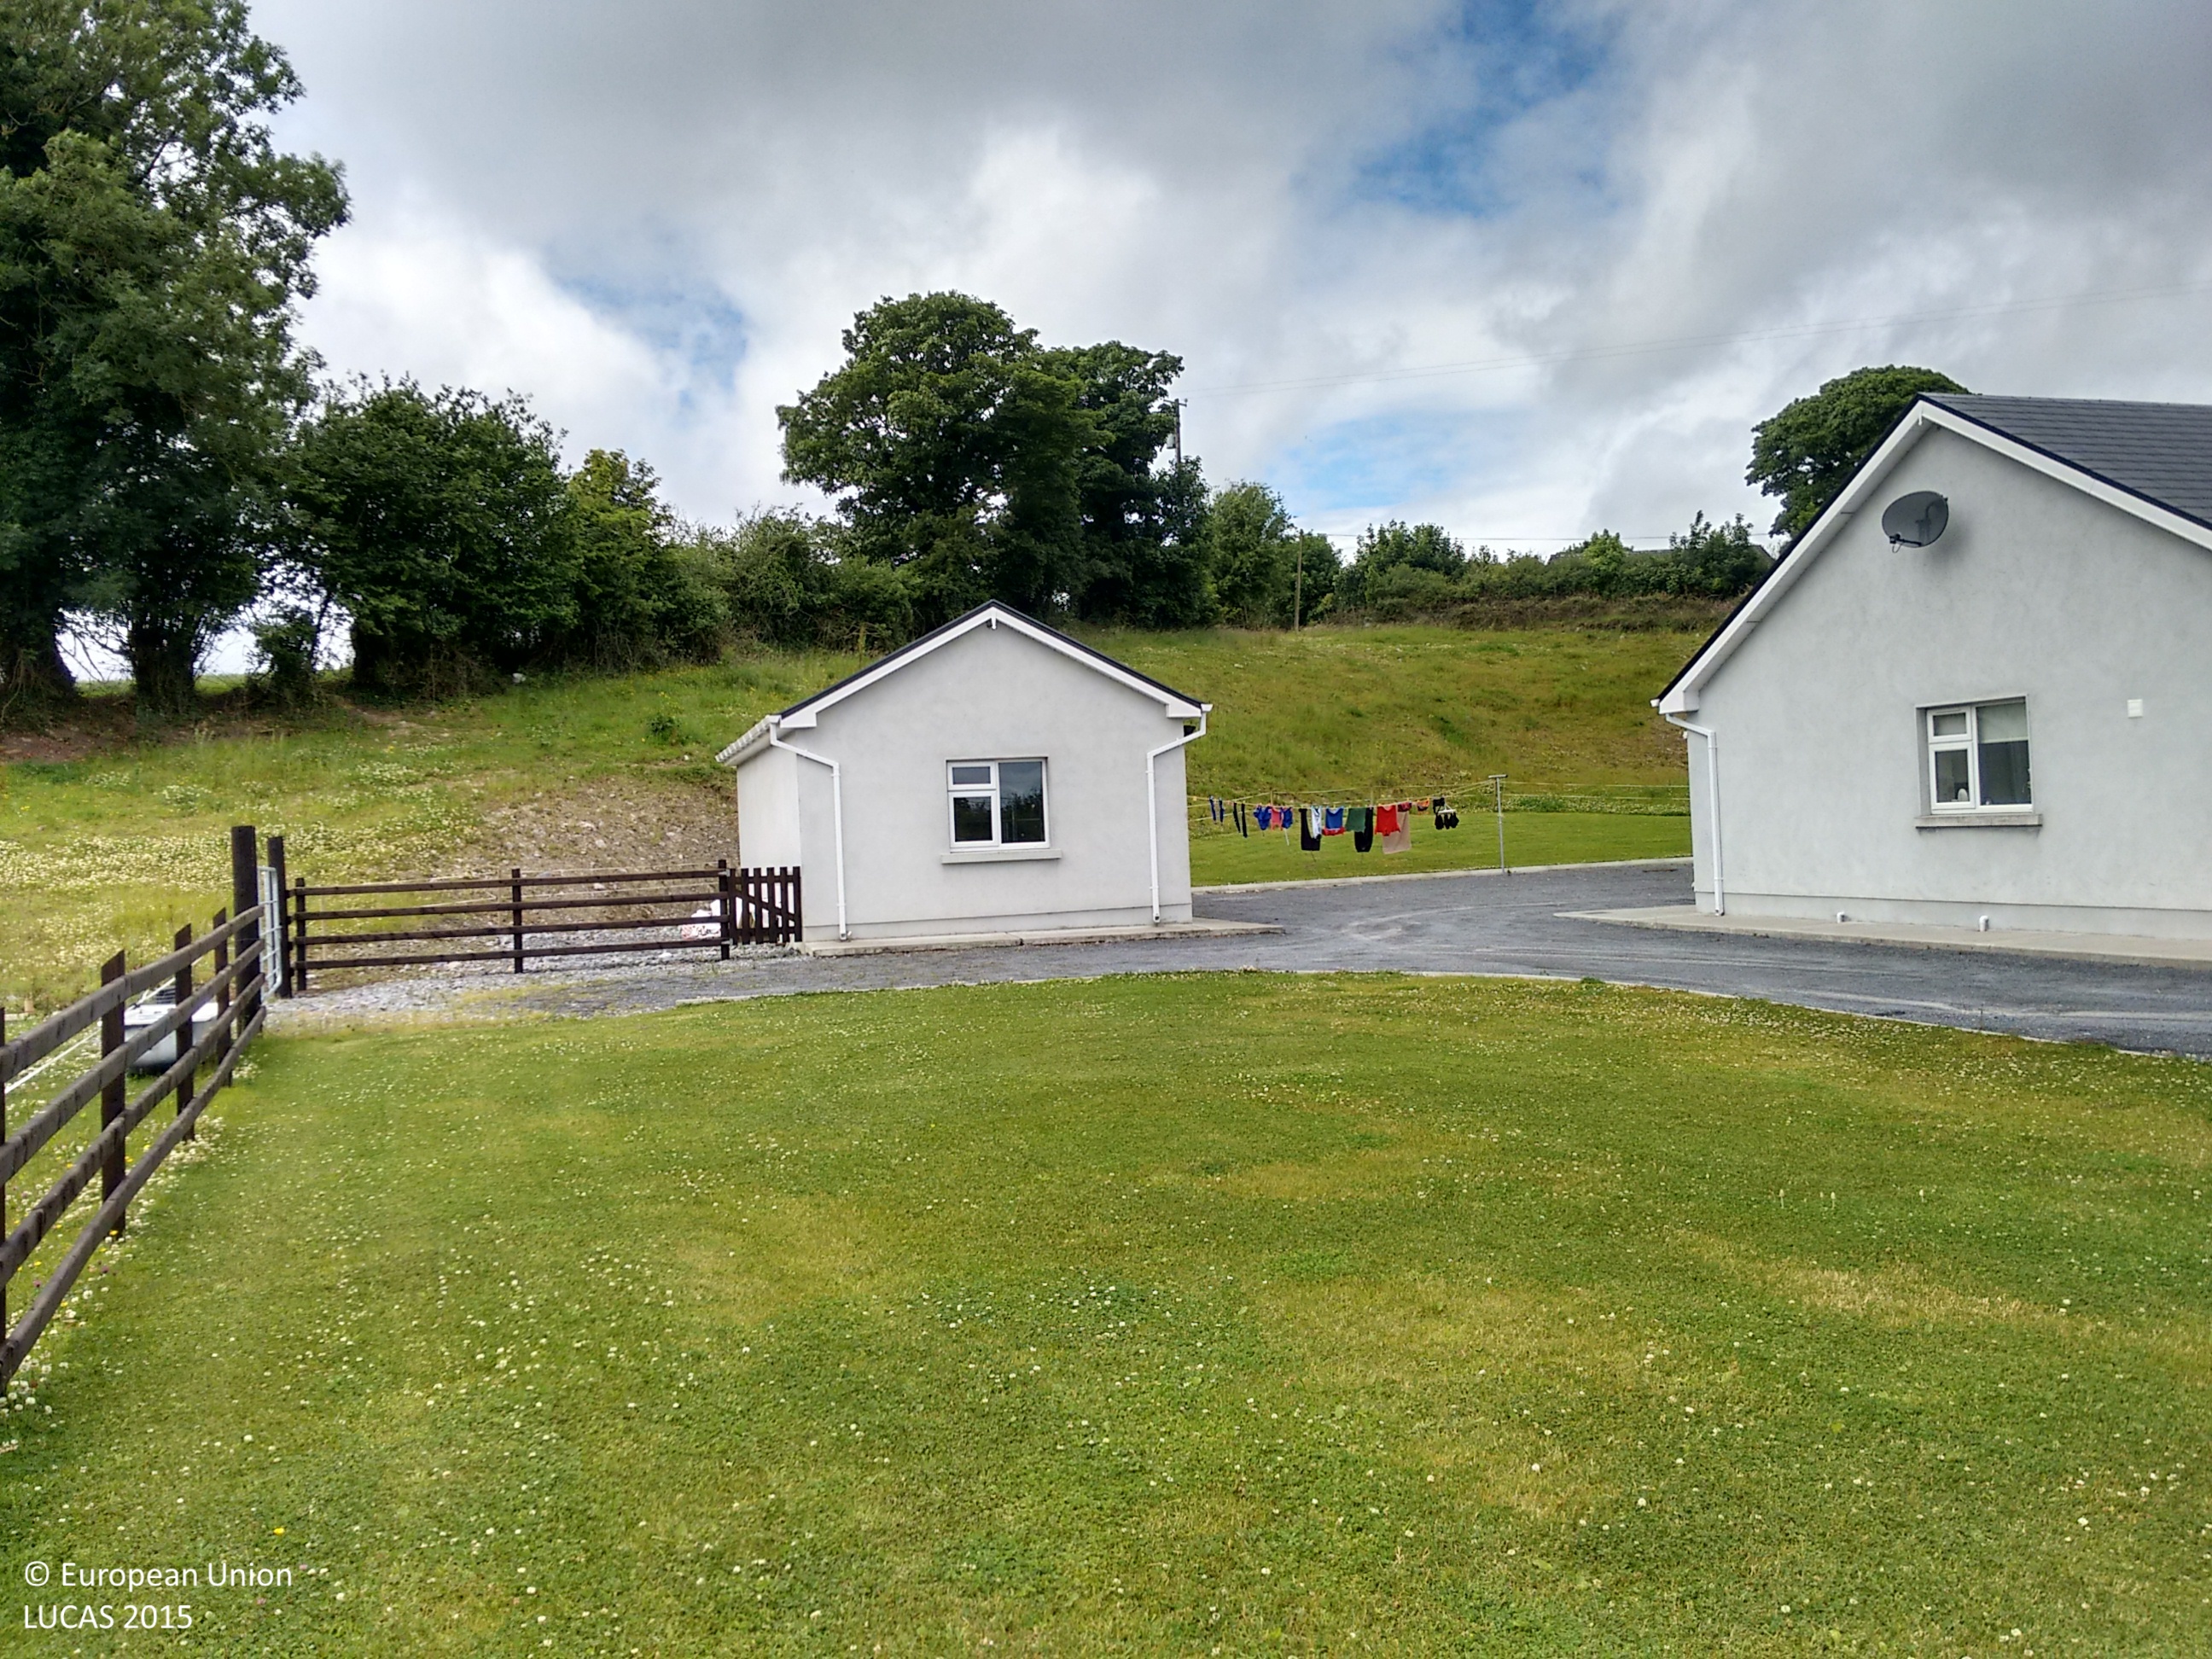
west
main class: Grassland
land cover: Grassland without tree/shrub cover
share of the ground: > 75 %
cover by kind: herbaceous plants 100 %
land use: Agriculture (excluding fallow land and kitchen gardens)
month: June
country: IE
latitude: 53.4368
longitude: -8.0136
